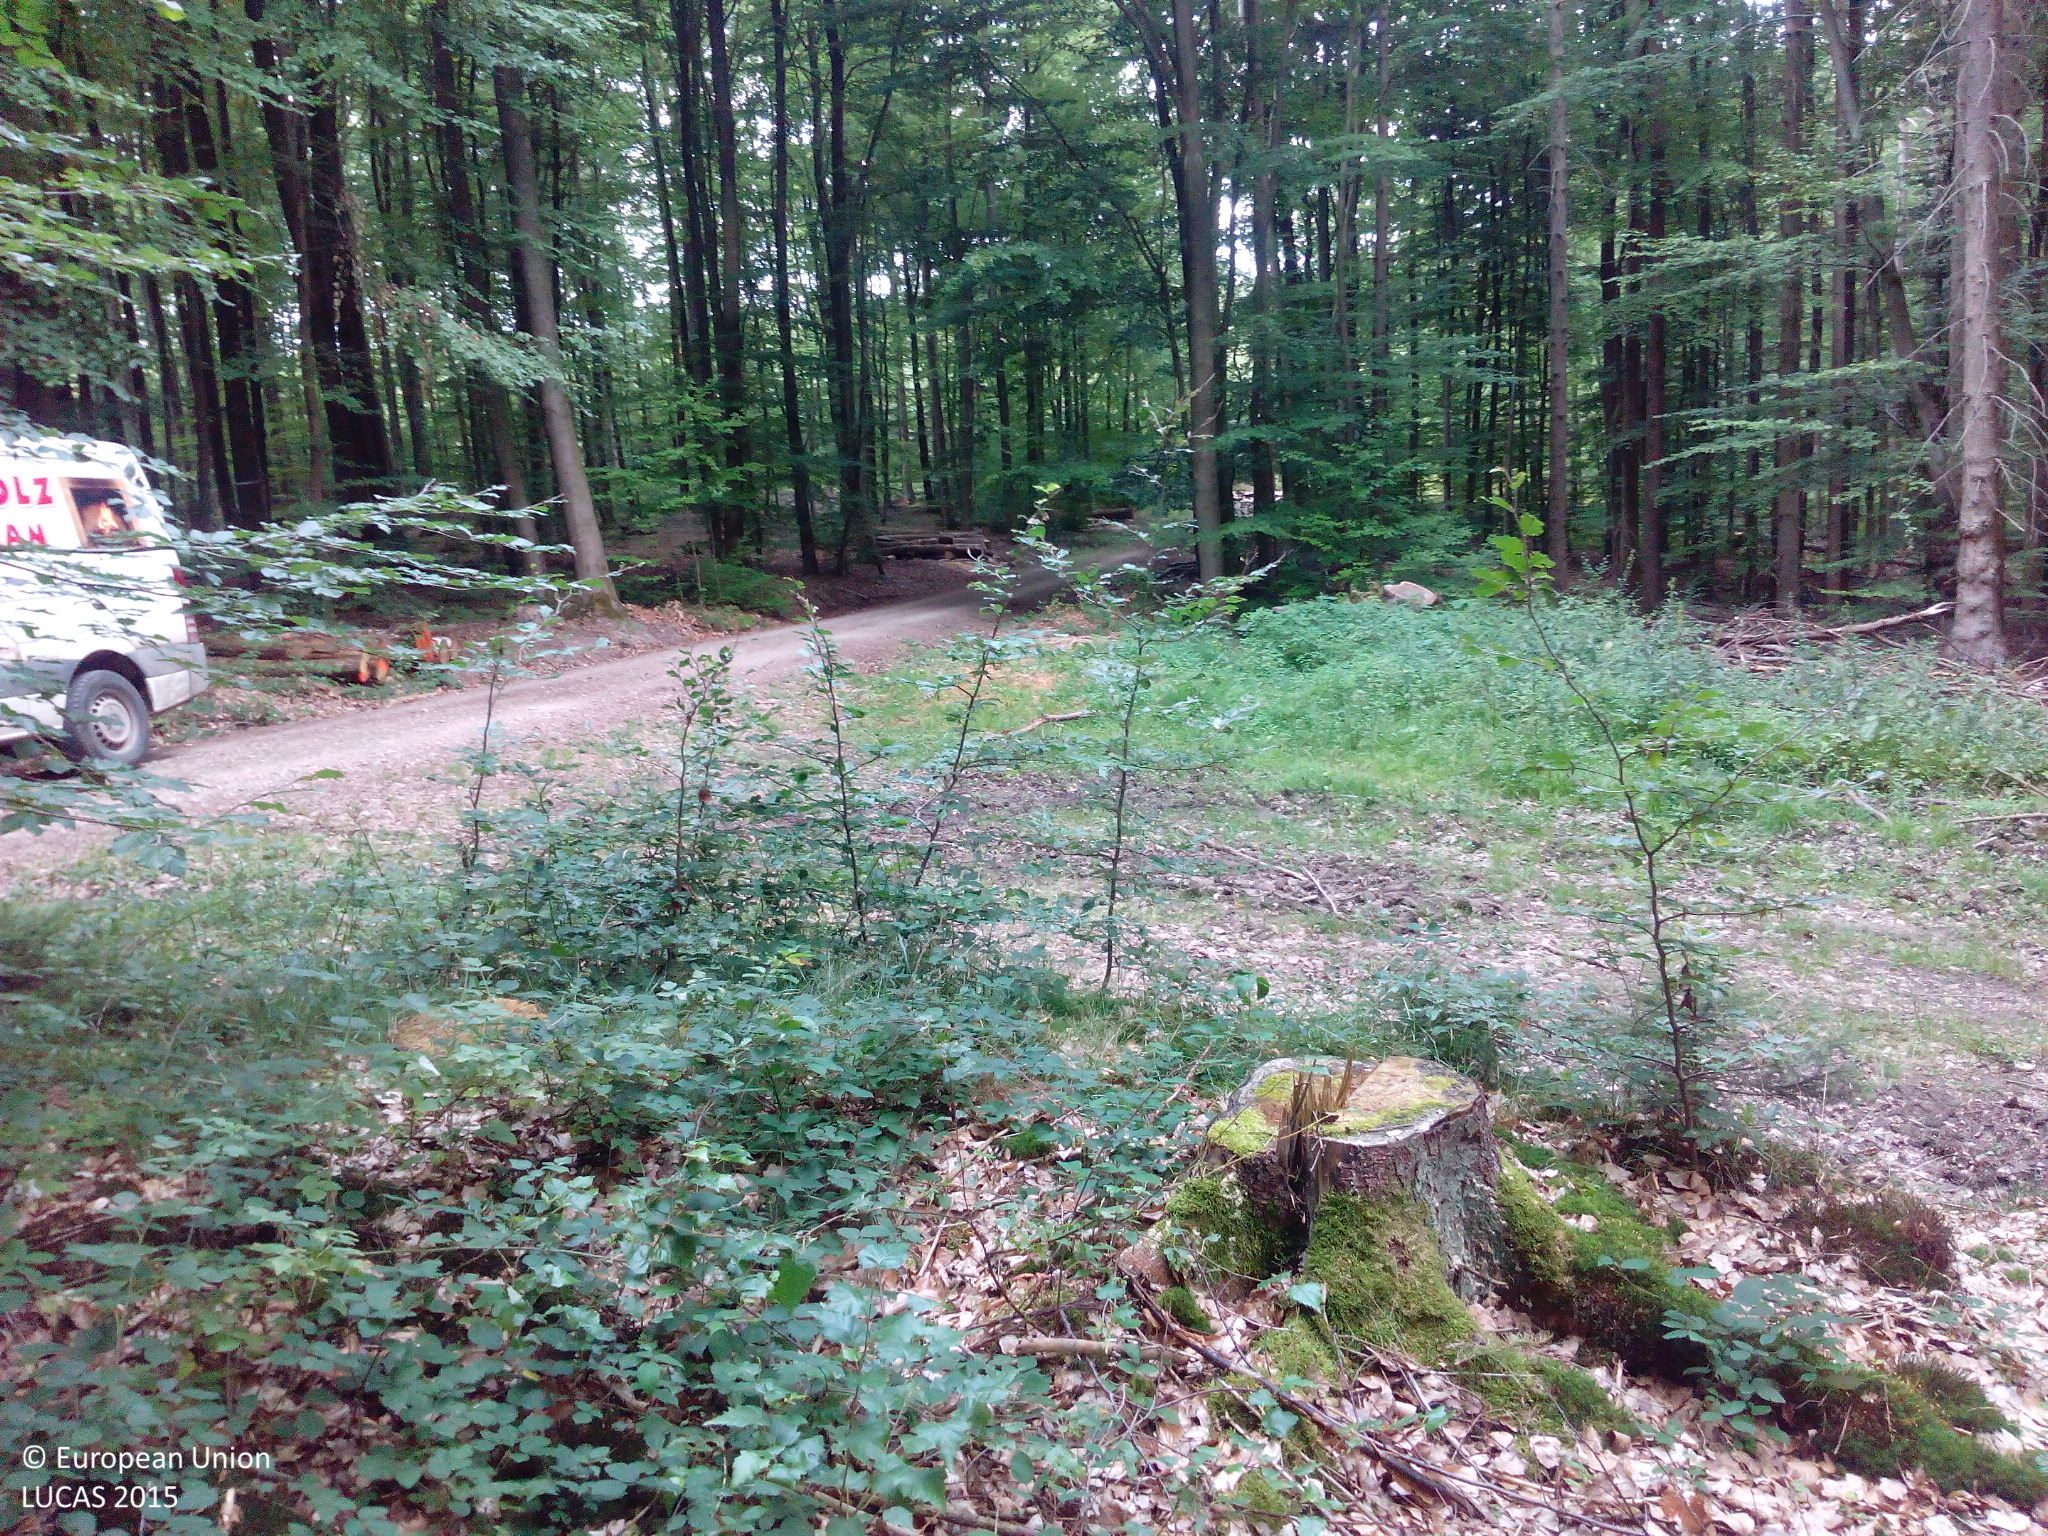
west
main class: Woodland
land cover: Other mixed woodland
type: hemiboreal forest and nemoral coniferous forest and mixed broadleaved-coniferous forest
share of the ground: 50 - 75 %
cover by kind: coniferous forest trees 45 %, unconsolidated bare surface 25 %, broadleaved forest trees 20 %, lichens and mosses 10 %
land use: Forestry
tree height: > 5 m
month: August
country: DE
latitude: 50.0792
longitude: 8.1418
